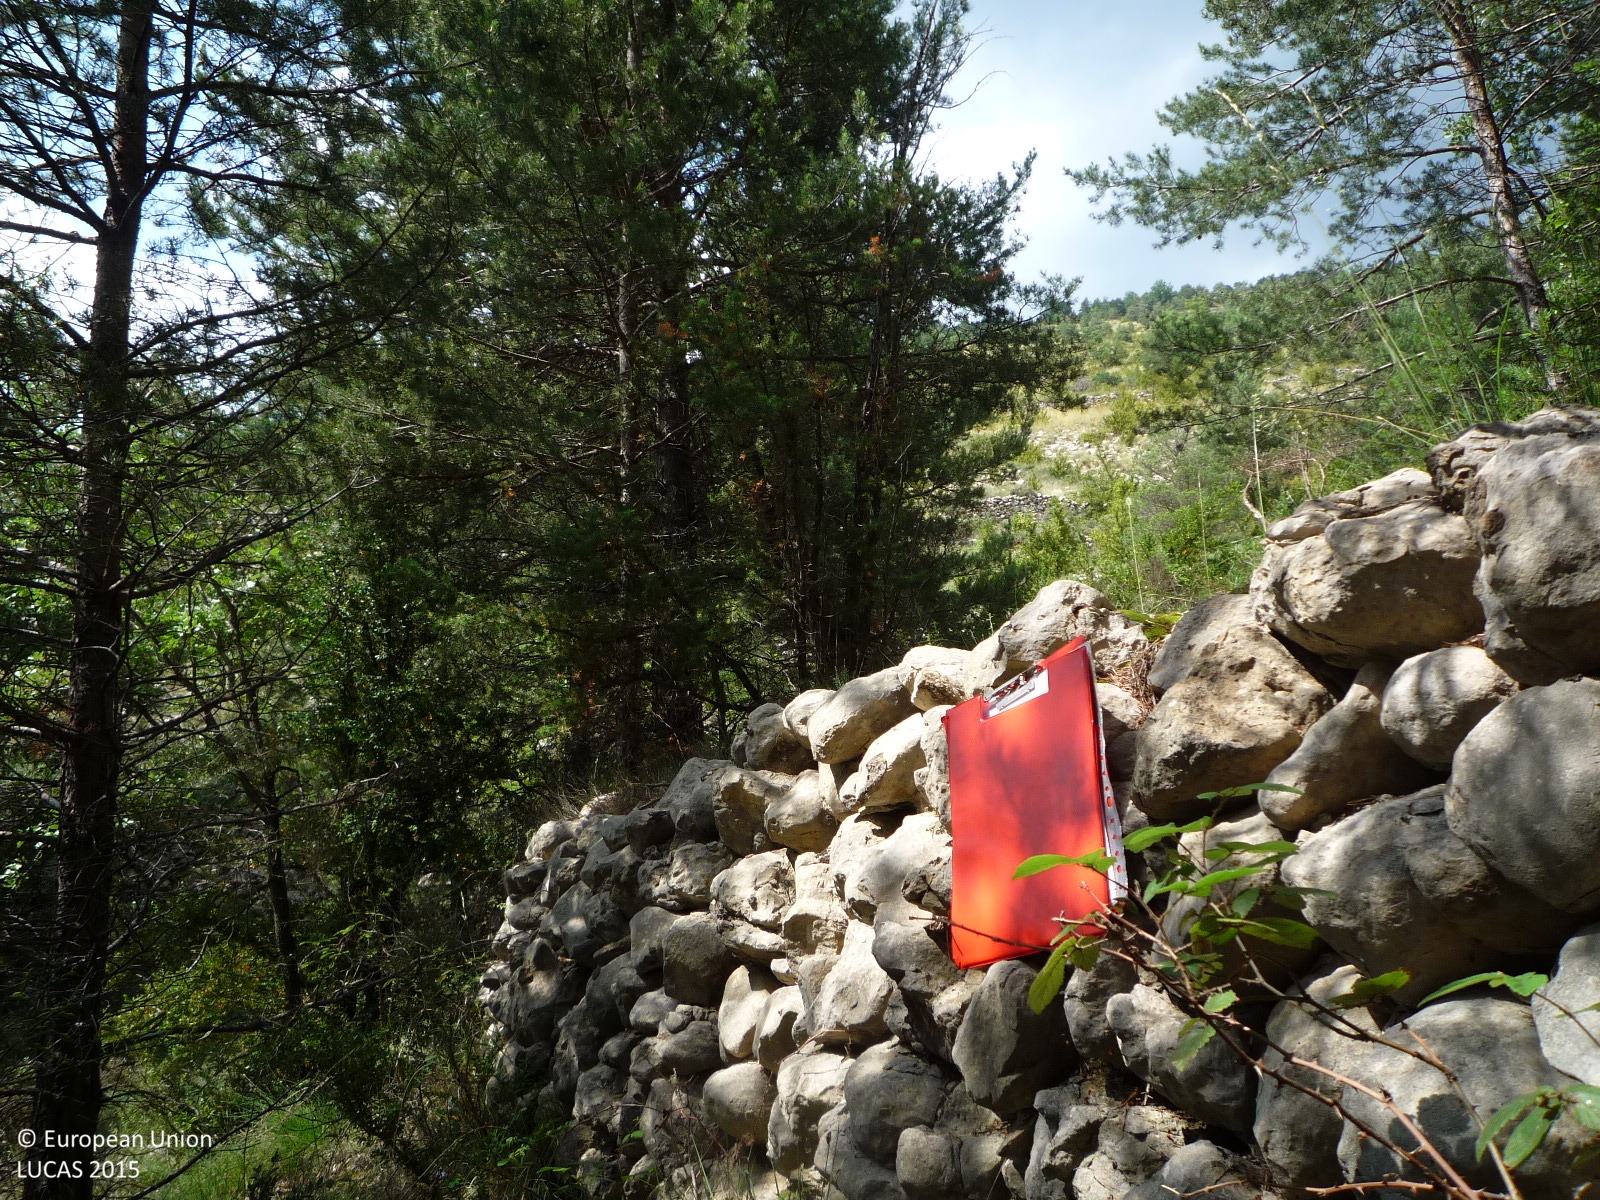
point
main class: Woodland
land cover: Pine dominated coniferous woodland
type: alpine coniferous forest
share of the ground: > 75 %
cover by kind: coniferous forest trees 80 %, herbaceous plants 20 %
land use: Semi-natural and natural areas not in use
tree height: > 5 m
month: June
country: ES
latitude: 42.2210
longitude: 1.9075
